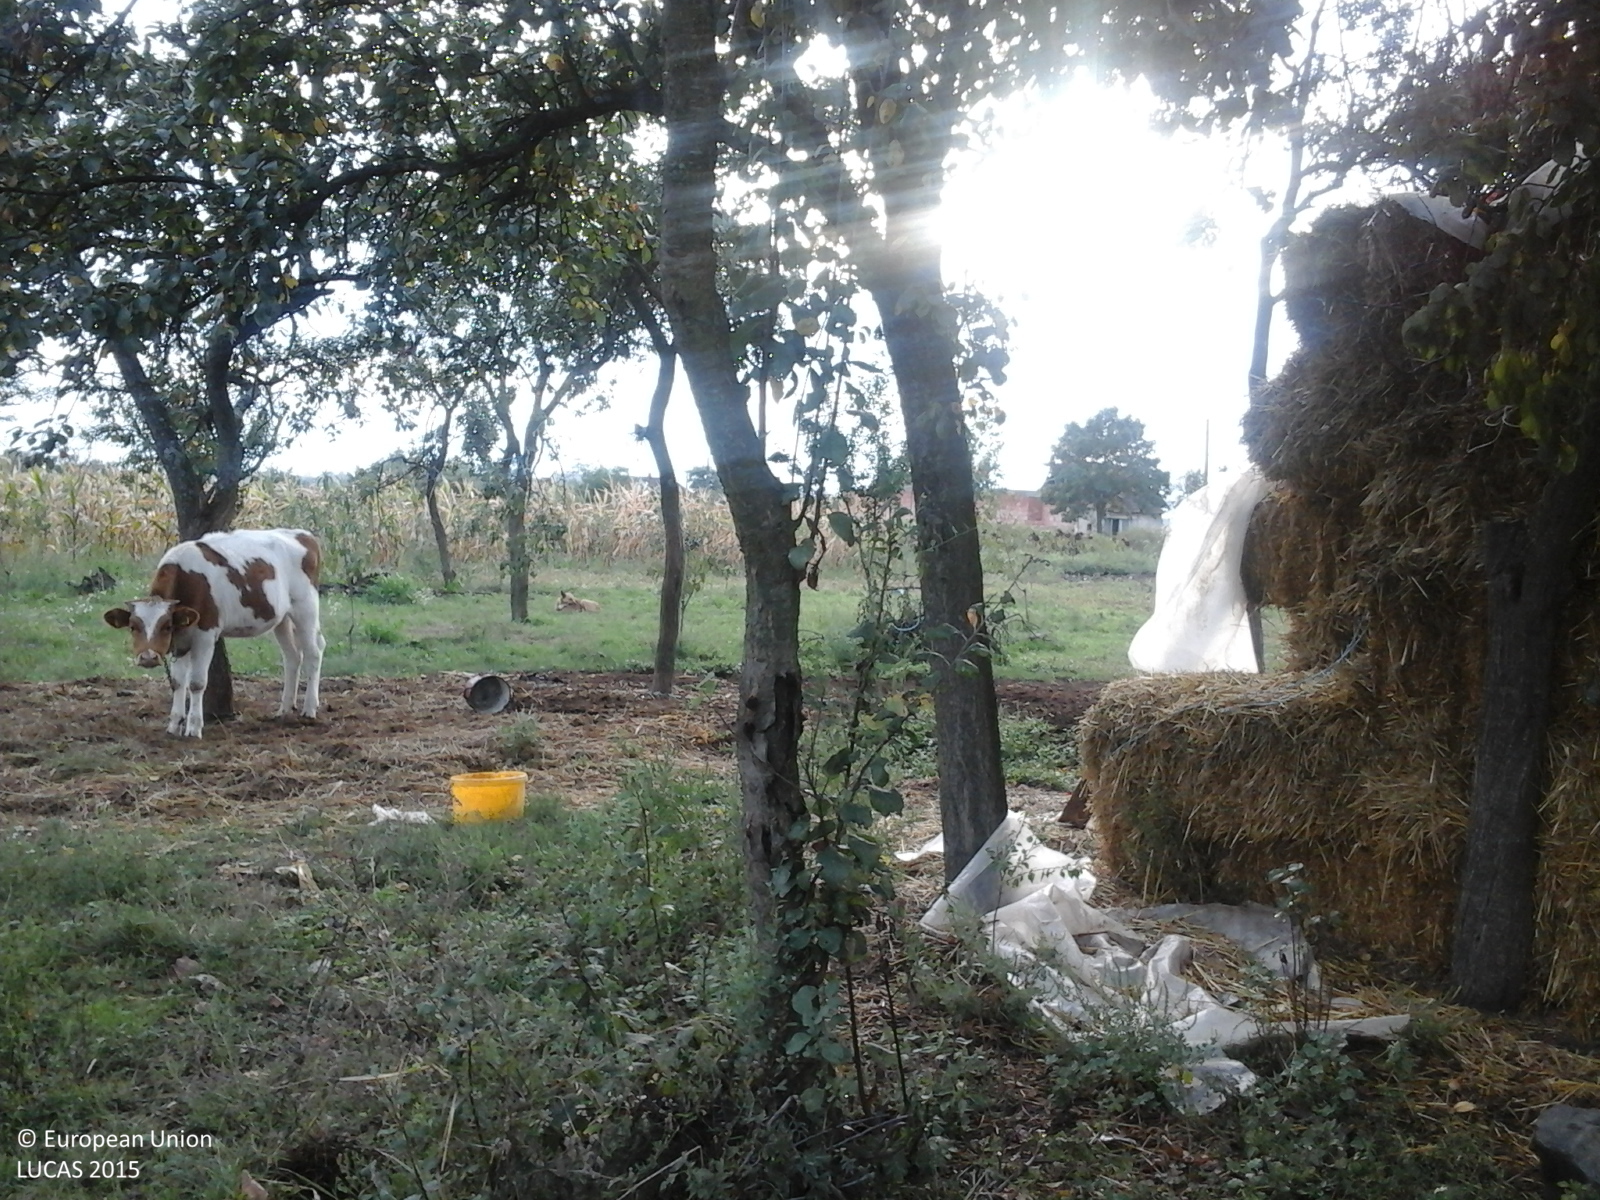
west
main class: Cropland
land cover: Other fruit trees and berries
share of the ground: > 75 %
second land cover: Grassland without tree/shrub cover
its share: > 75 %
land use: Agriculture (excluding fallow land and kitchen gardens)
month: September
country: RO
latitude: 47.4498
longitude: 22.5374
